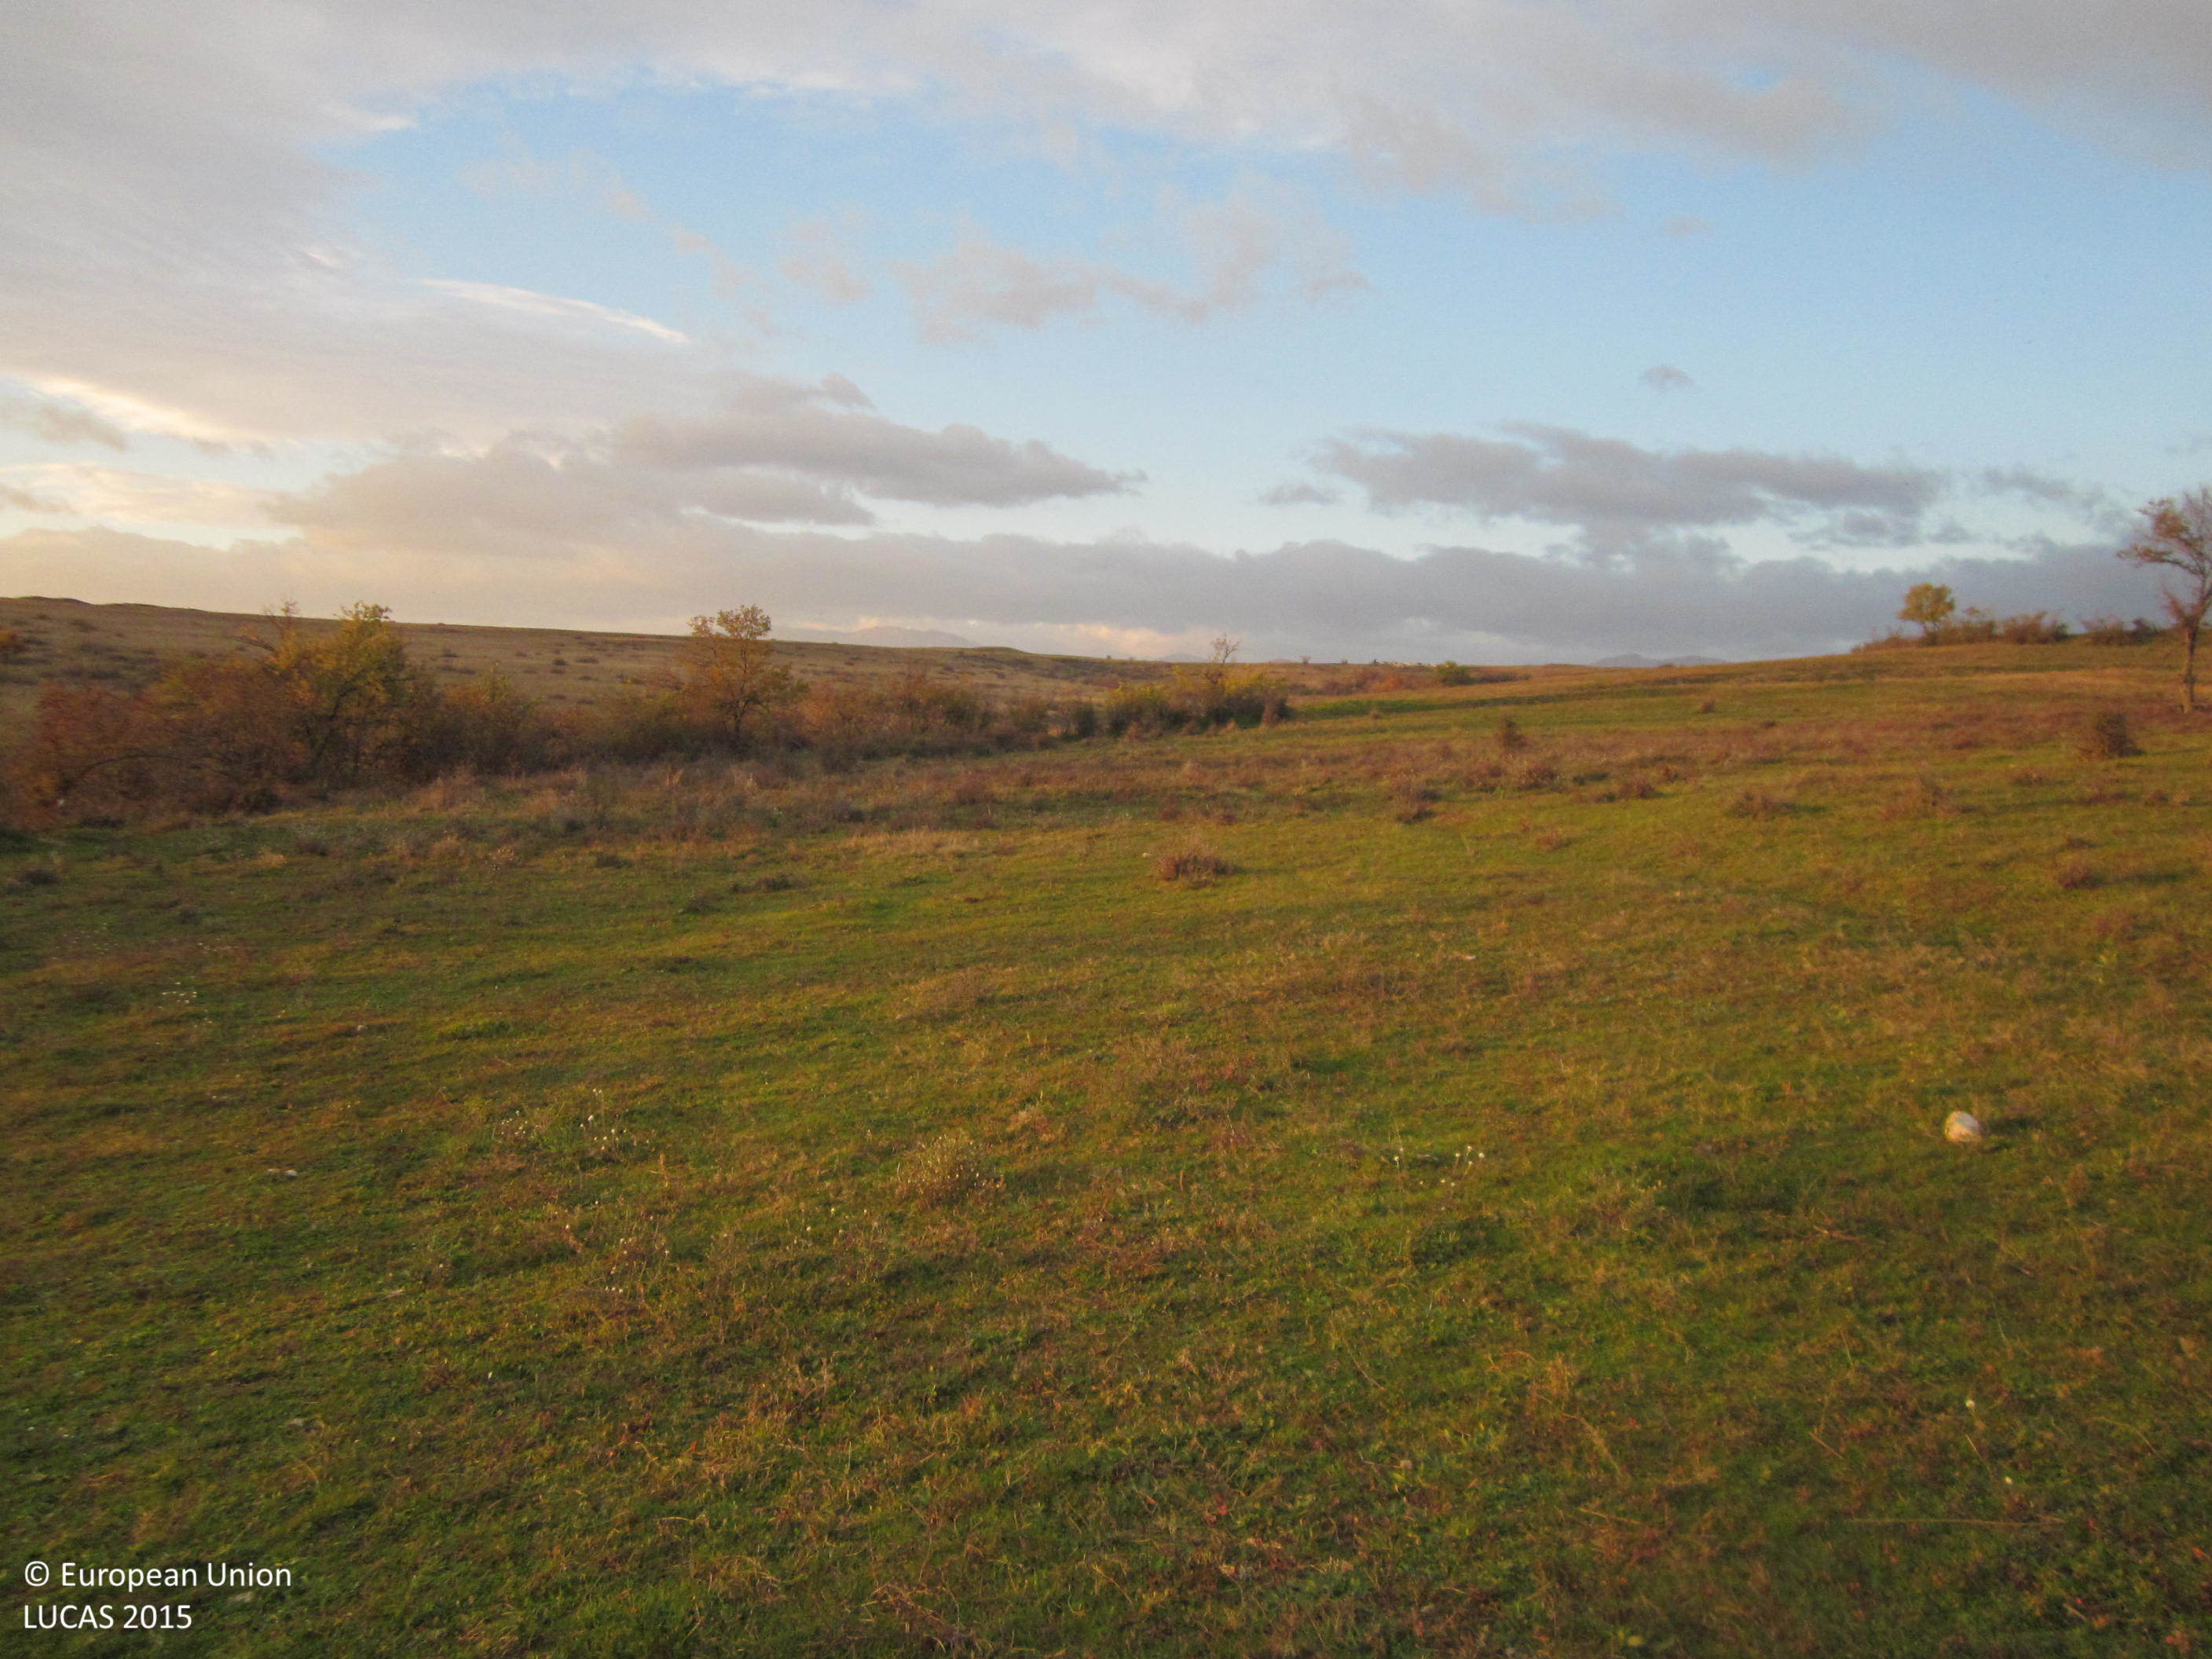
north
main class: Grassland
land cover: Grassland without tree/shrub cover
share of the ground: > 75 %
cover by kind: herbaceous plants 100 %
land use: Agriculture (excluding fallow land and kitchen gardens)
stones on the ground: < 10 %
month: November
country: BG
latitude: 42.4639
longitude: 24.6347
